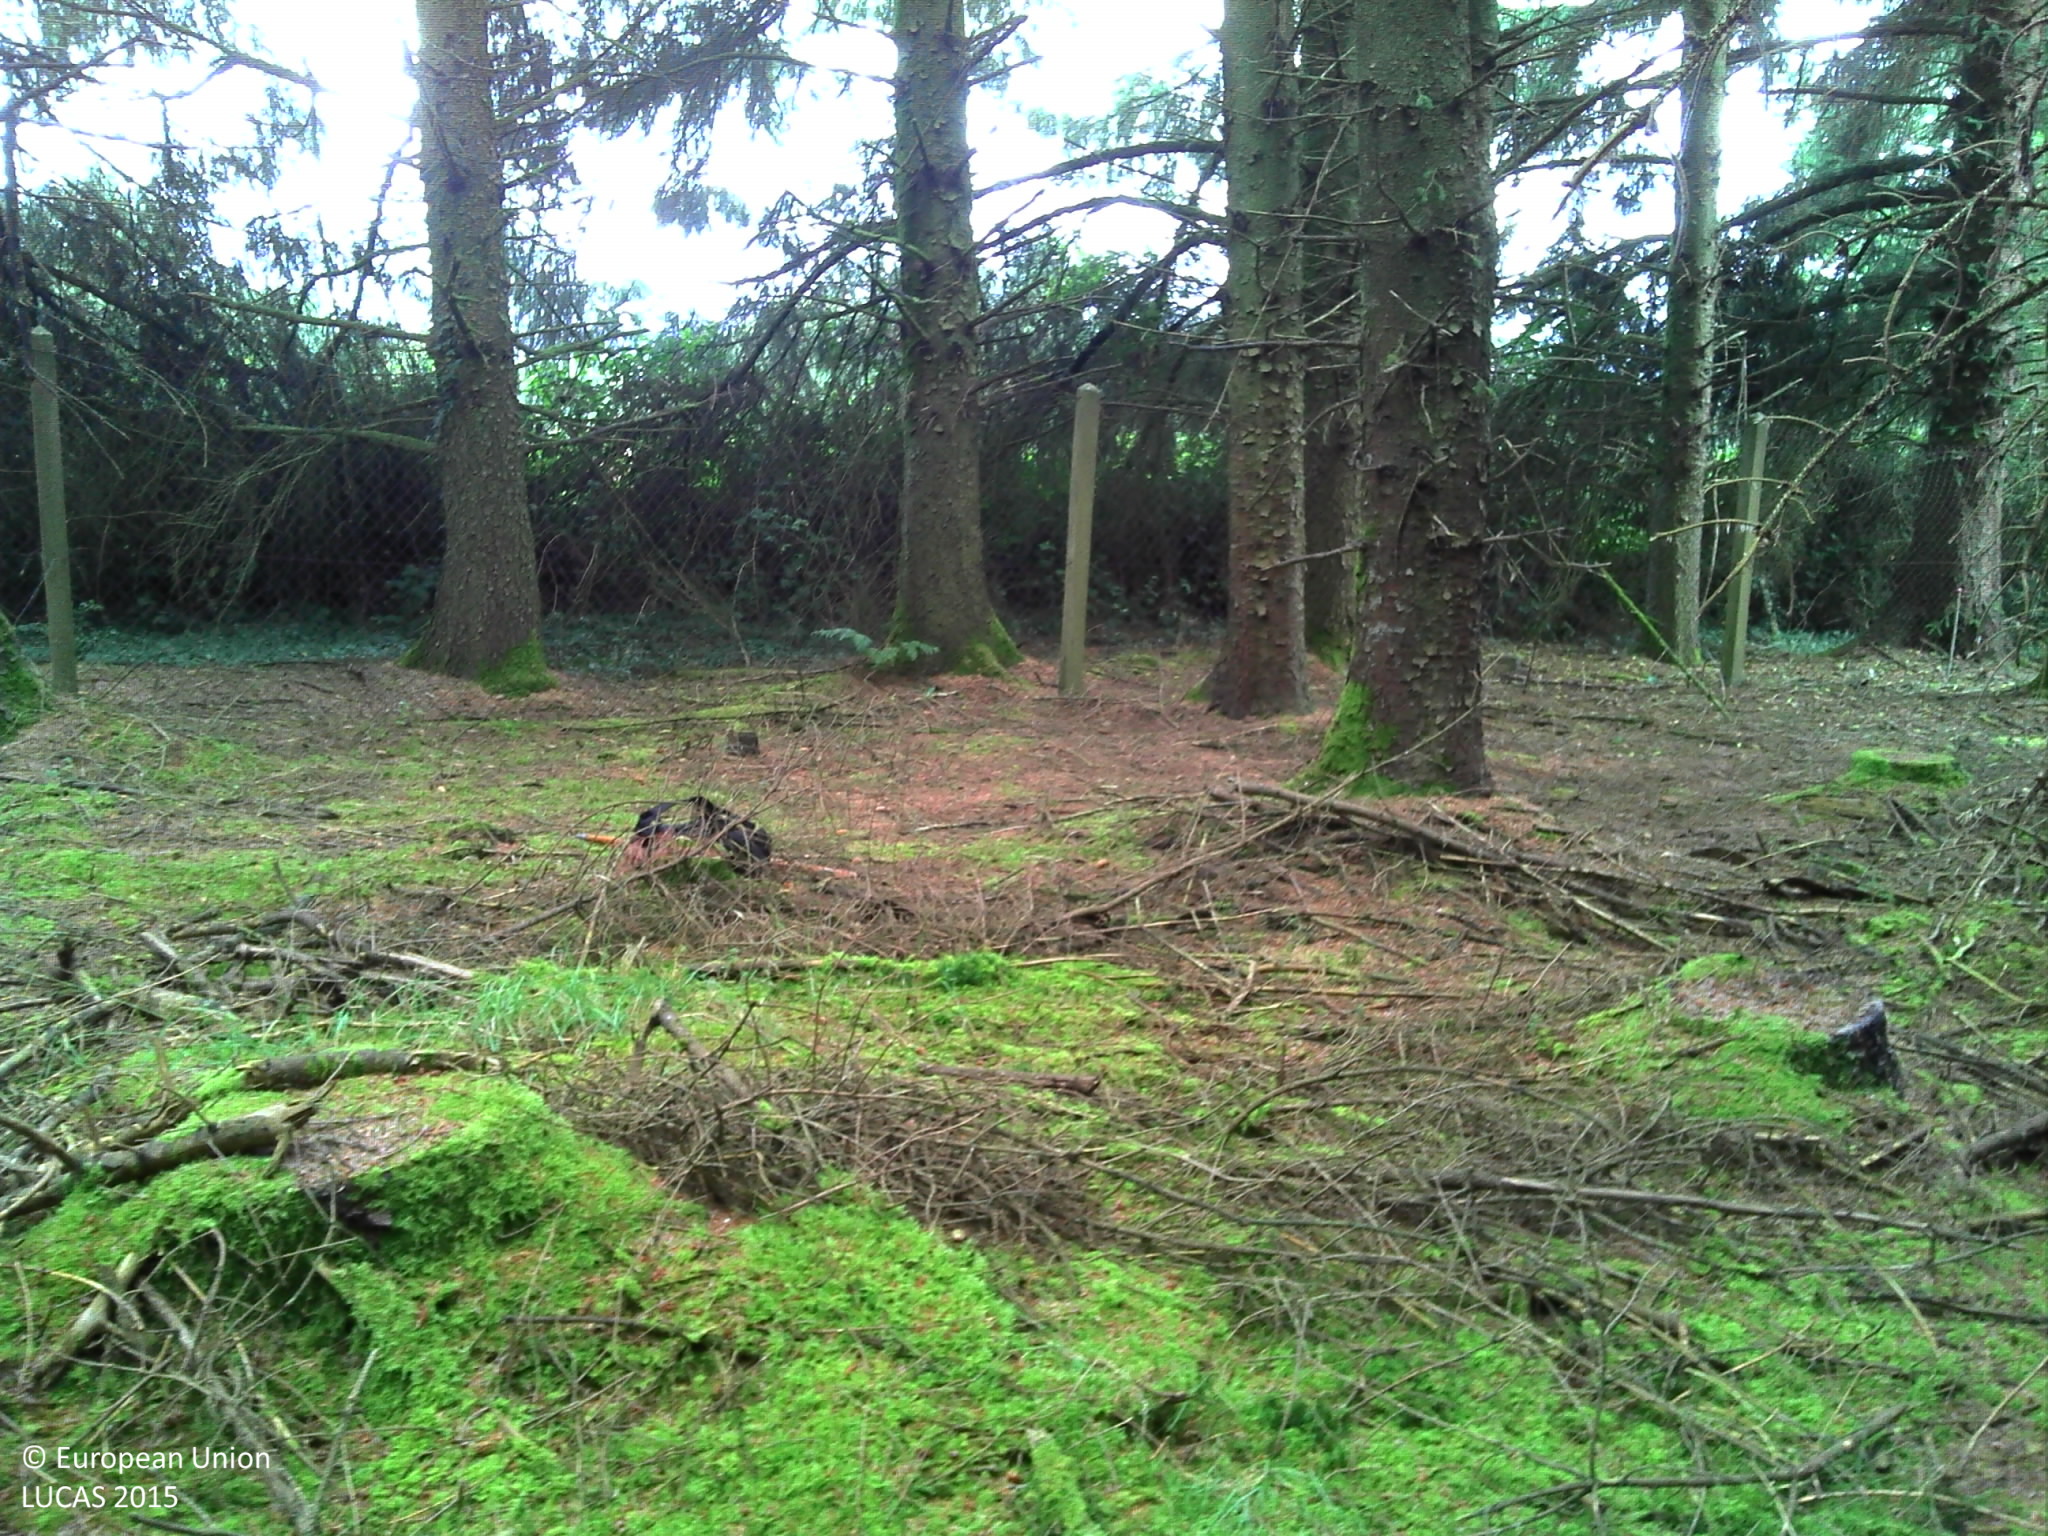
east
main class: Woodland
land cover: Spruce dominated coniferous woodland
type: exotic forest
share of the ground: > 75 %
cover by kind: coniferous forest trees 70 %, lichens and mosses 15 %, shrubs 5 %, herbaceous plants 5 %, consolidated bare surface 5 %
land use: Forestry
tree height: > 5 m
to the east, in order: Spruce dominated coniferous woodland; Fences; Grassland without tree/shrub cover; Abandoned hedges; Grassland without tree/shrub cover; Broadleaved woodland; Grassland without tree/shrub cover
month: July
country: FR
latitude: 48.1549
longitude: -3.6439
